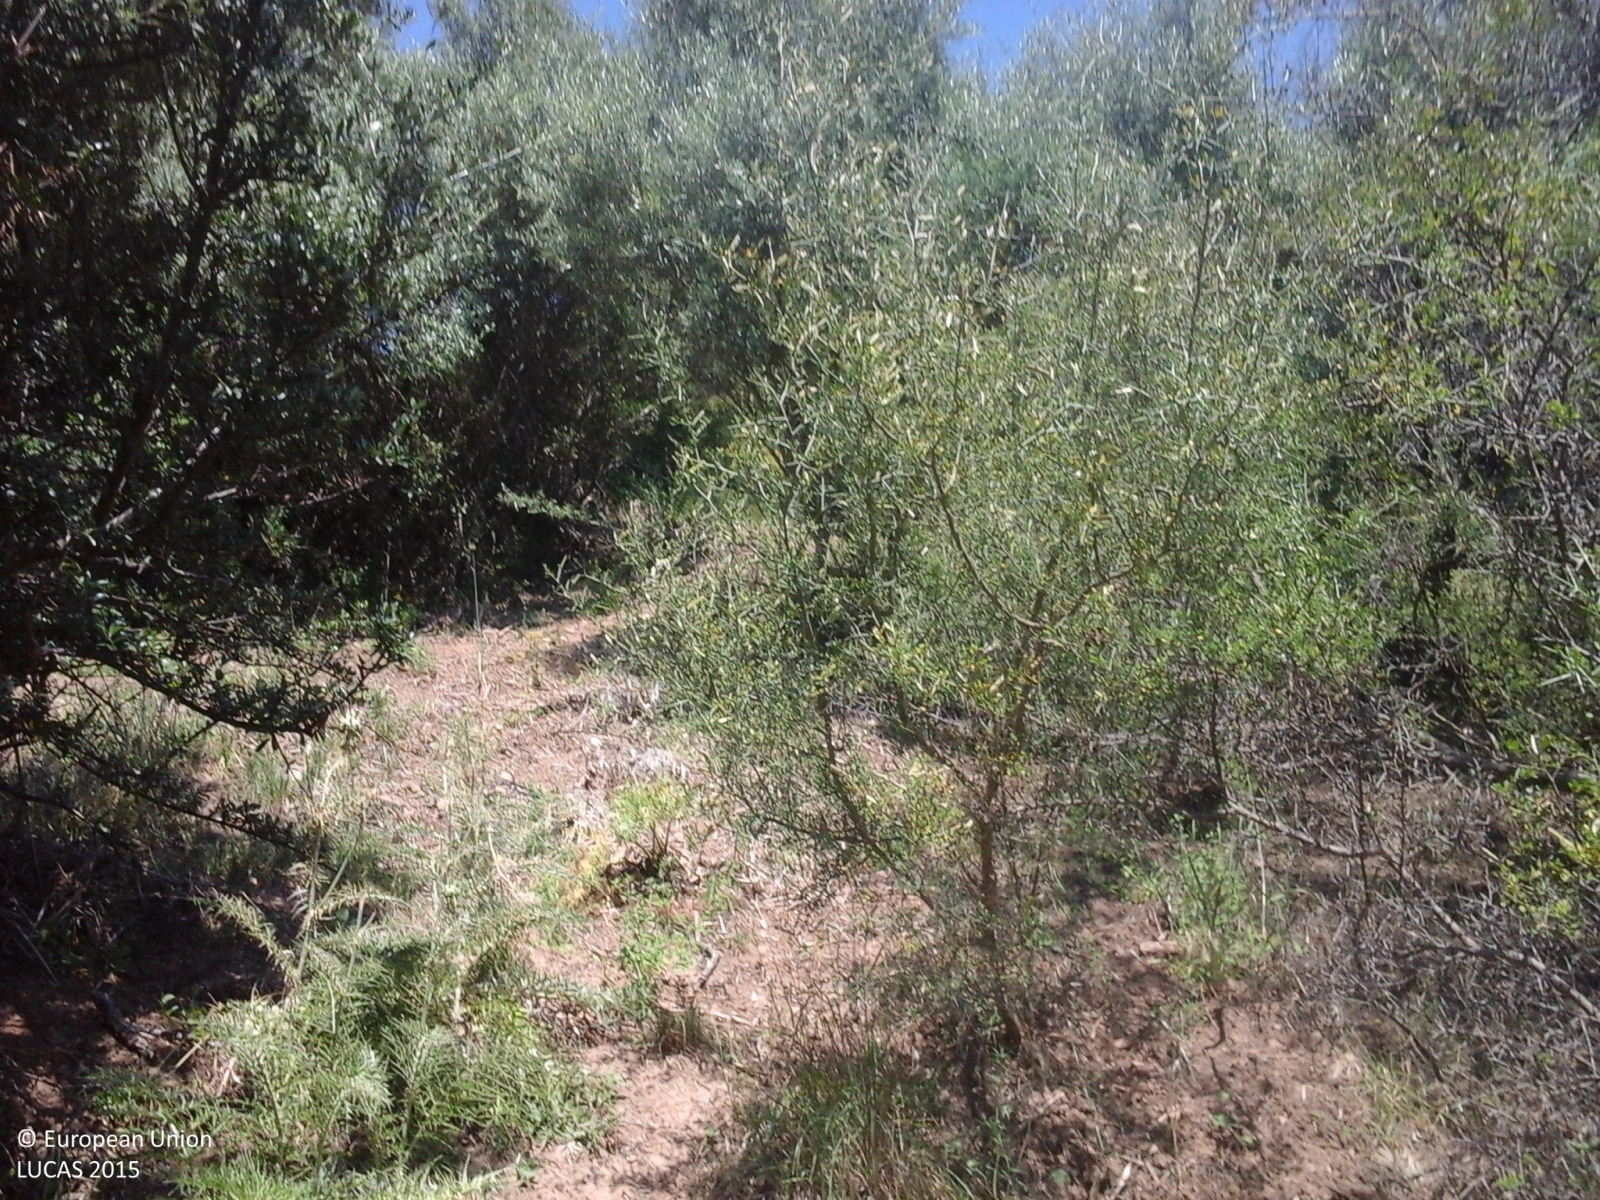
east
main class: Woodland
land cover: Broadleaved woodland
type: broadleaved evergreen forest
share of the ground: > 75 %
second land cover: Grassland without tree/shrub cover
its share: > 75 %
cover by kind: broadleaved forest trees 45 %, shrubs 40 %, herbaceous plants 15 %
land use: Forestry
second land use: Agriculture (excluding fallow land and kitchen gardens)
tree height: > 5 m
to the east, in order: Broadleaved woodland; Grassland without tree/shrub cover; Olive groves; Tracks; Olive groves; Tracks; Broadleaved woodland; Fences; Broadleaved woodland
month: June
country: IT
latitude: 37.9297
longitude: 14.1464
